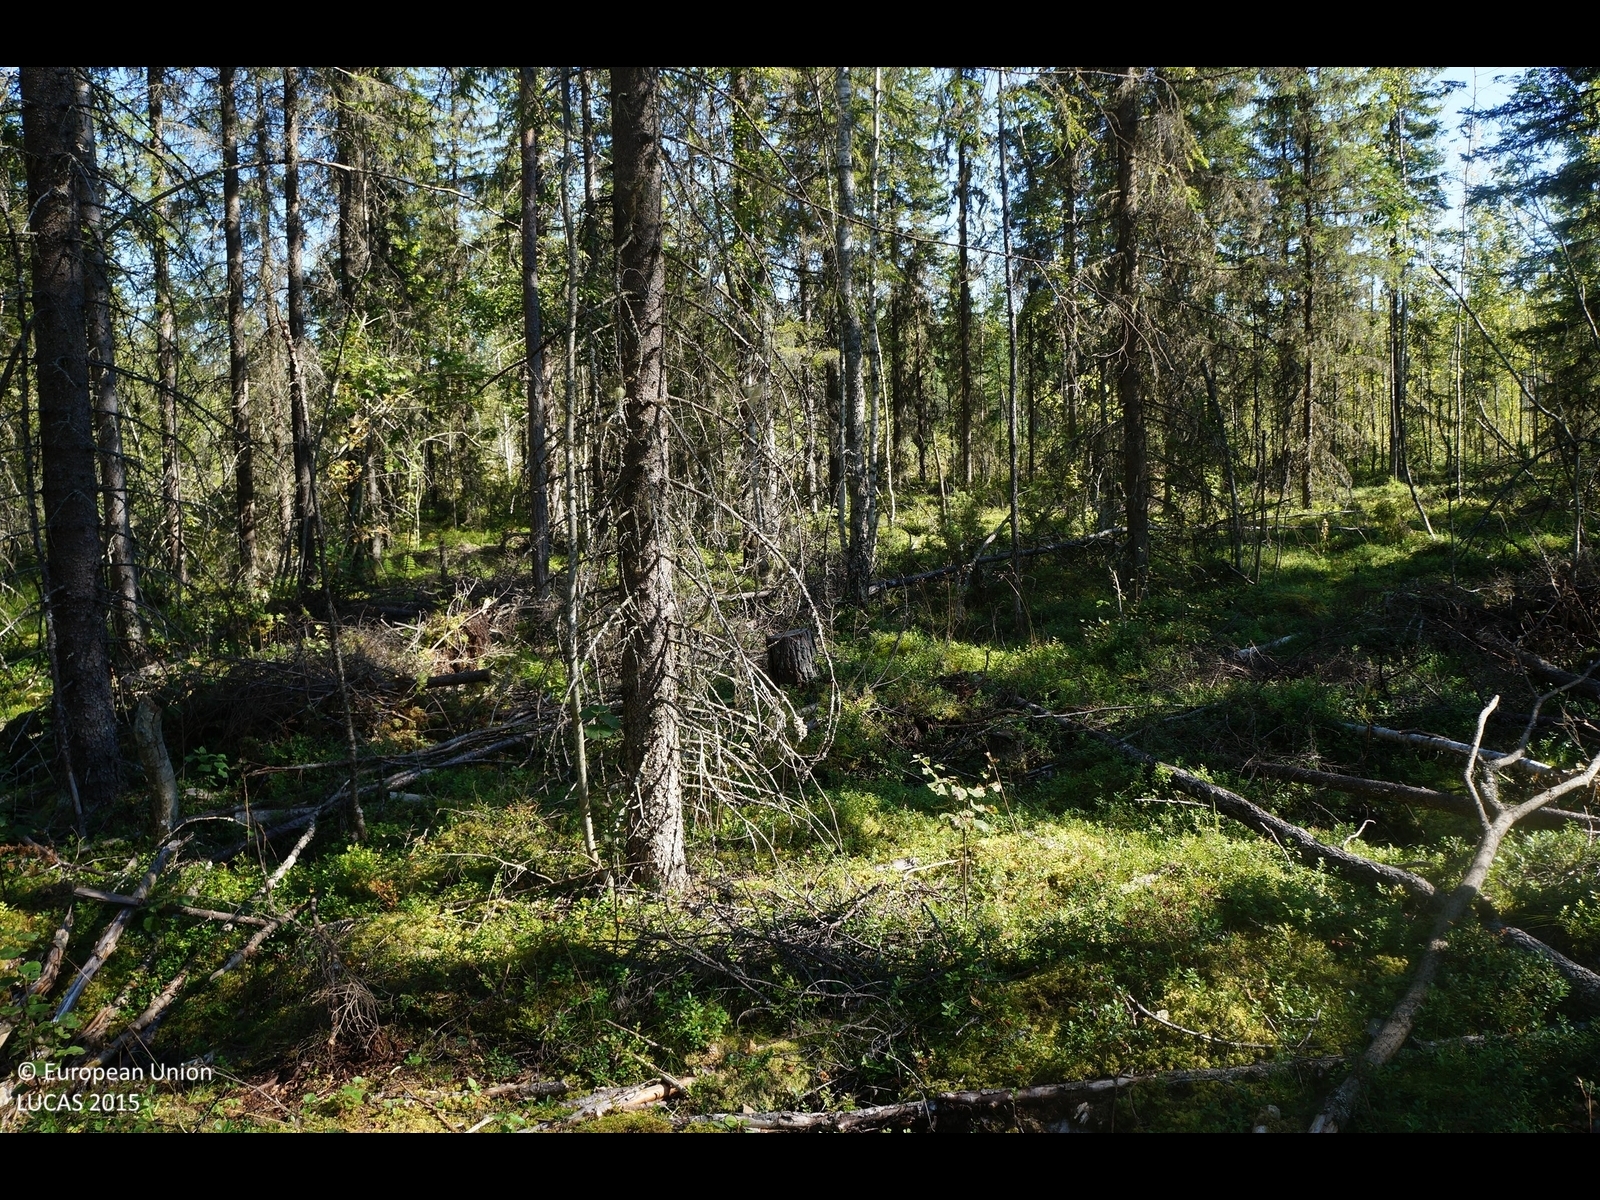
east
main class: Woodland
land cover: Spruce dominated coniferous woodland
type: boreal forest
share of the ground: 50 - 75 %
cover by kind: coniferous forest trees 50 %, shrubs 35 %, lichens and mosses 10 %, herbaceous plants 5 %
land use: Forestry
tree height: > 5 m
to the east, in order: Spruce dominated coniferous woodland; Tracks; Other mixed woodland; Lichens and moss; Pine dominated coniferous woodland; Other mixed woodland; Other coniferous woodland; Spruce dominated coniferous woodland; Pine dominated coniferous woodland
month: August
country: FI
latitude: 64.0141
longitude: 25.1643
